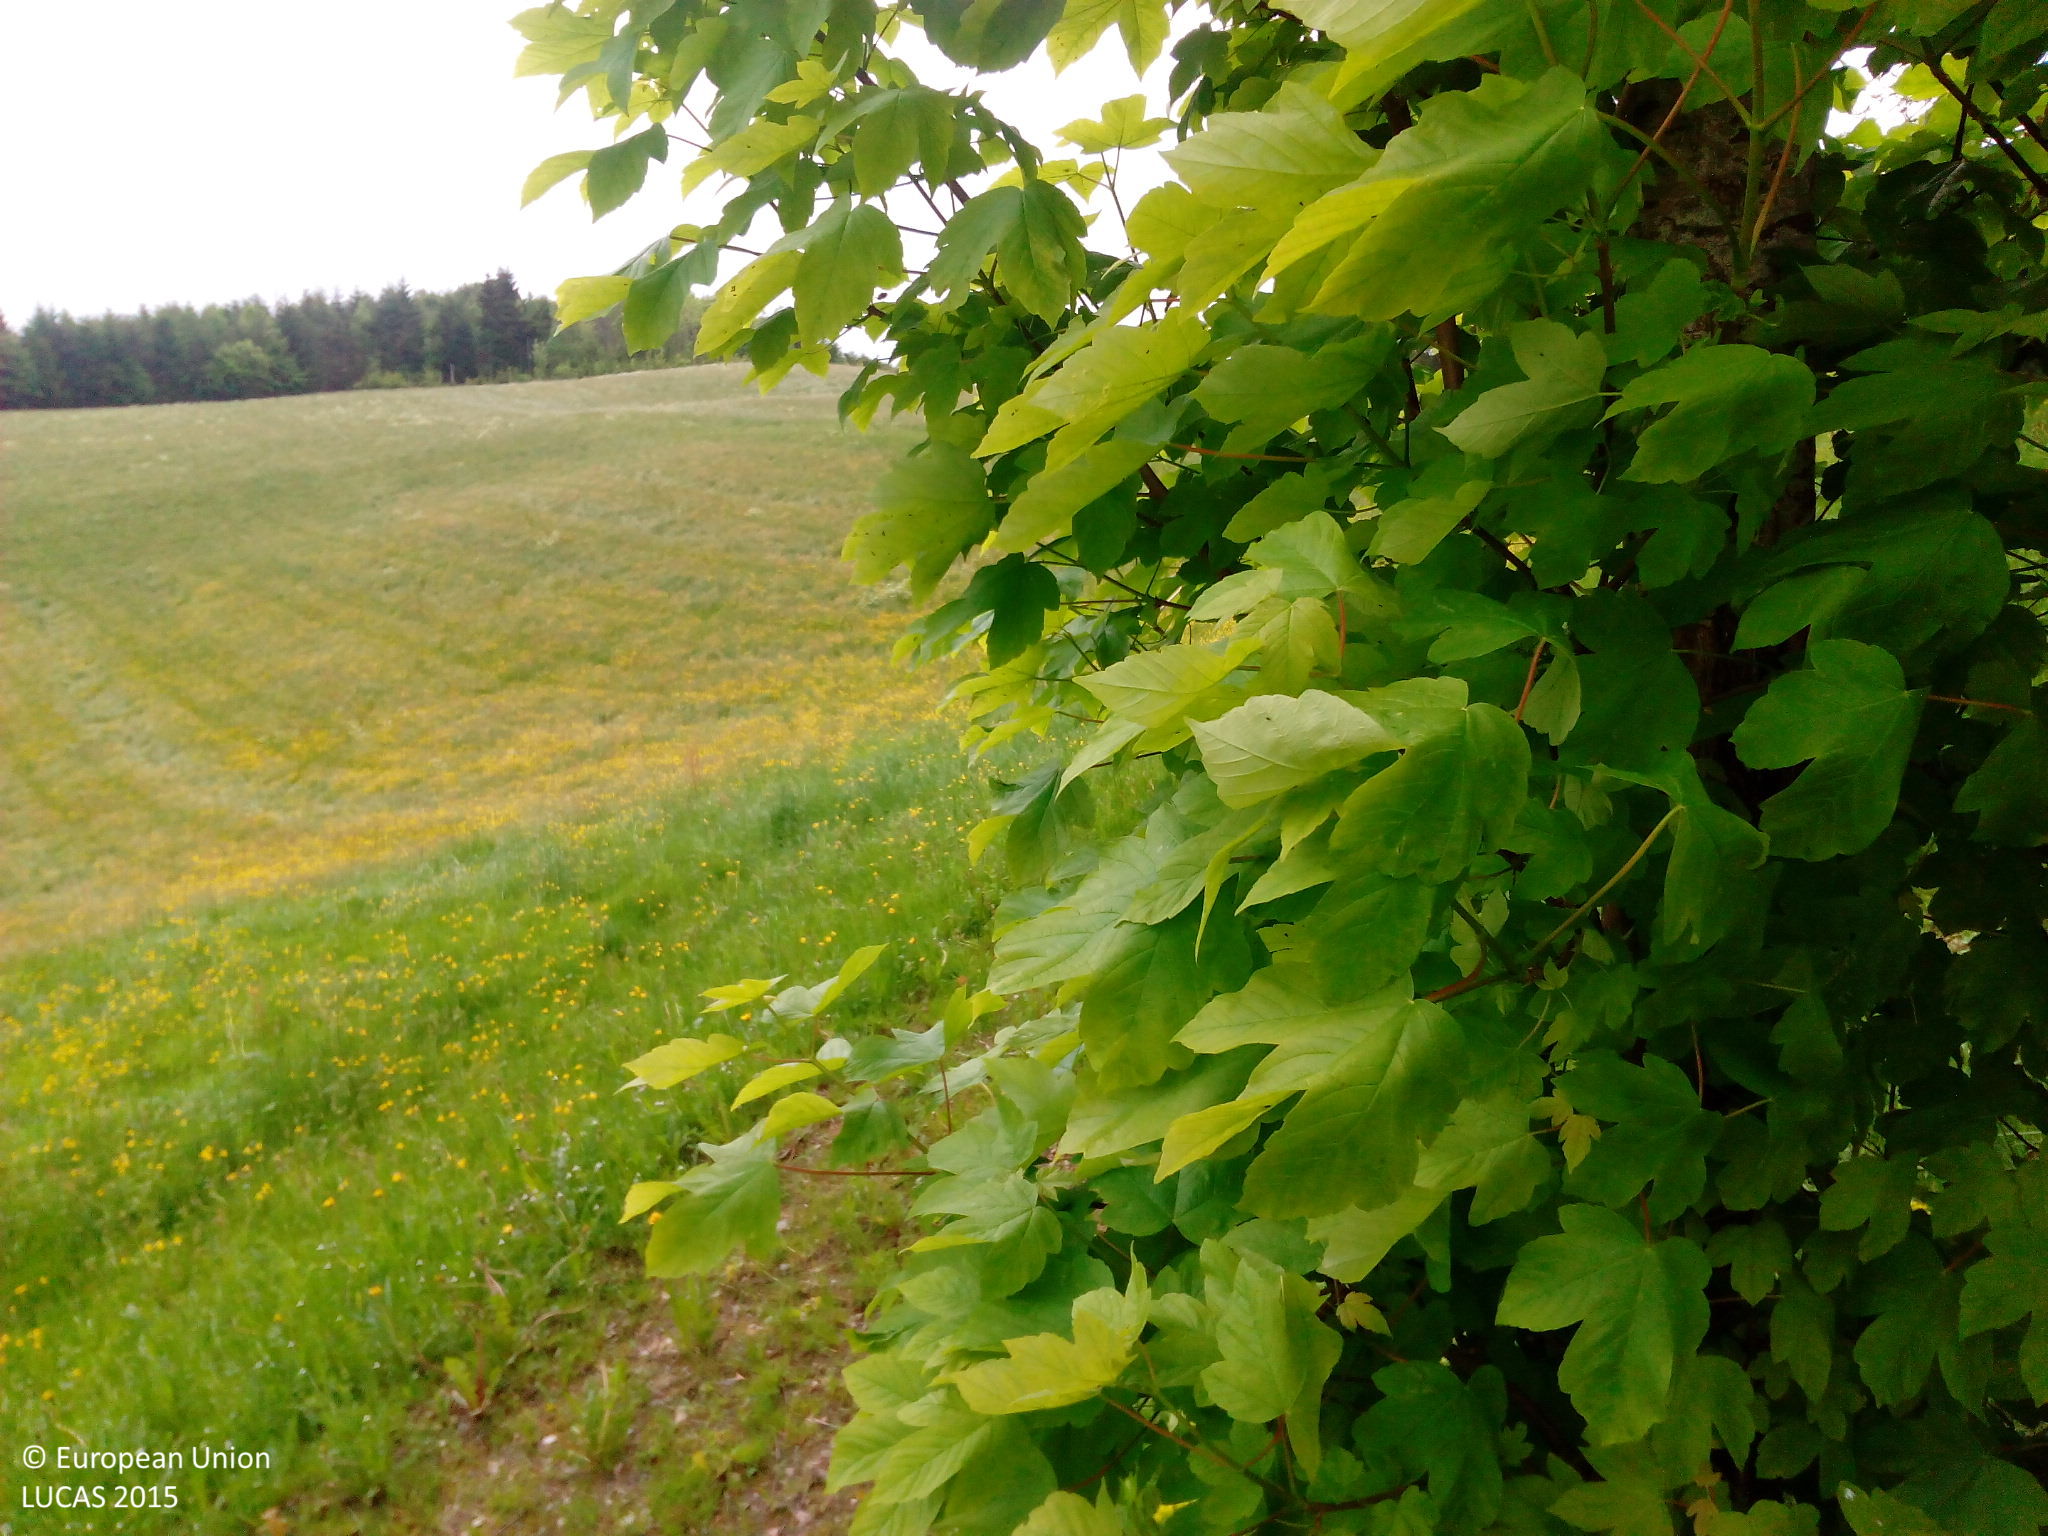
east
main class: Grassland
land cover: Grassland without tree/shrub cover
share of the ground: > 75 %
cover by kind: herbaceous plants 100 %
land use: Agriculture (excluding fallow land and kitchen gardens)
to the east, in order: Grass margins; Single bushes/trees; Tracks; Grassland without tree/shrub cover; Other coniferous woodland
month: May
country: DE
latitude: 47.8275
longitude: 9.8532
